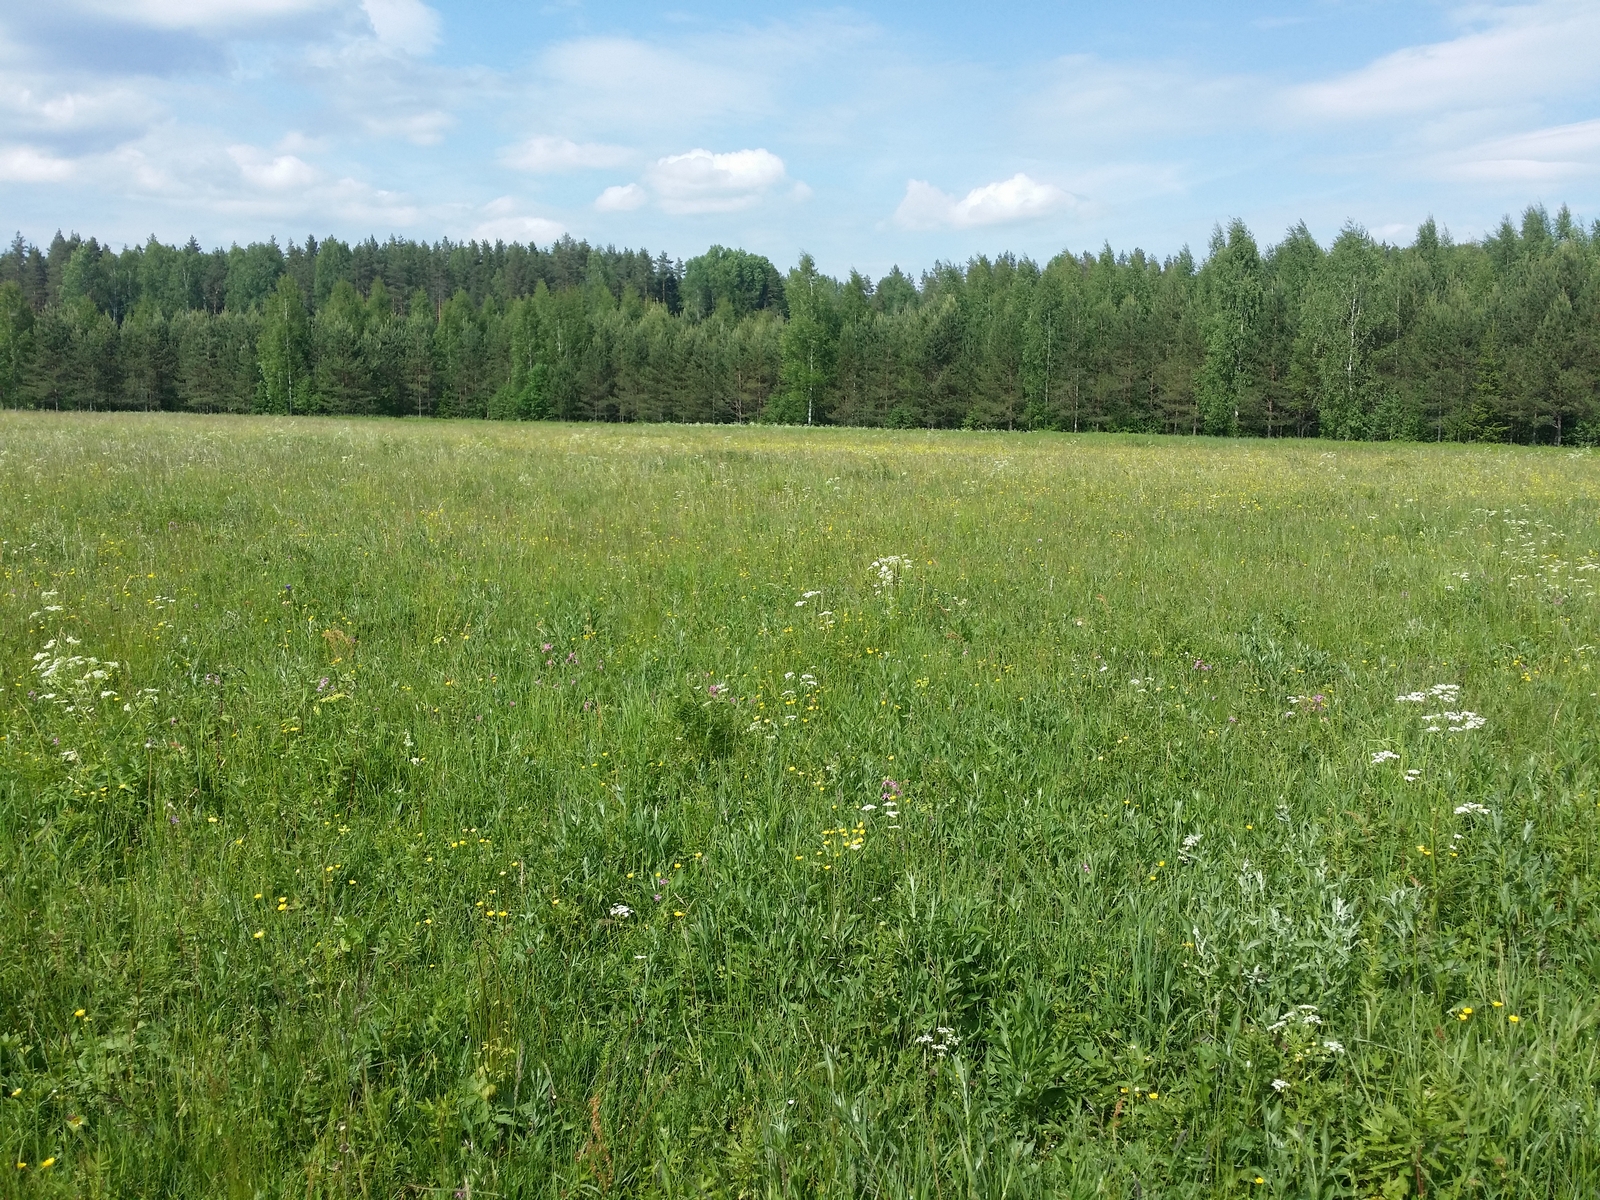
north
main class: Grassland
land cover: Spontaneously vegetated surfaces
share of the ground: > 75 %
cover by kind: herbaceous plants 100 %
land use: Fallow land
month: June
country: LV
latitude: 57.3740
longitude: 26.4902
